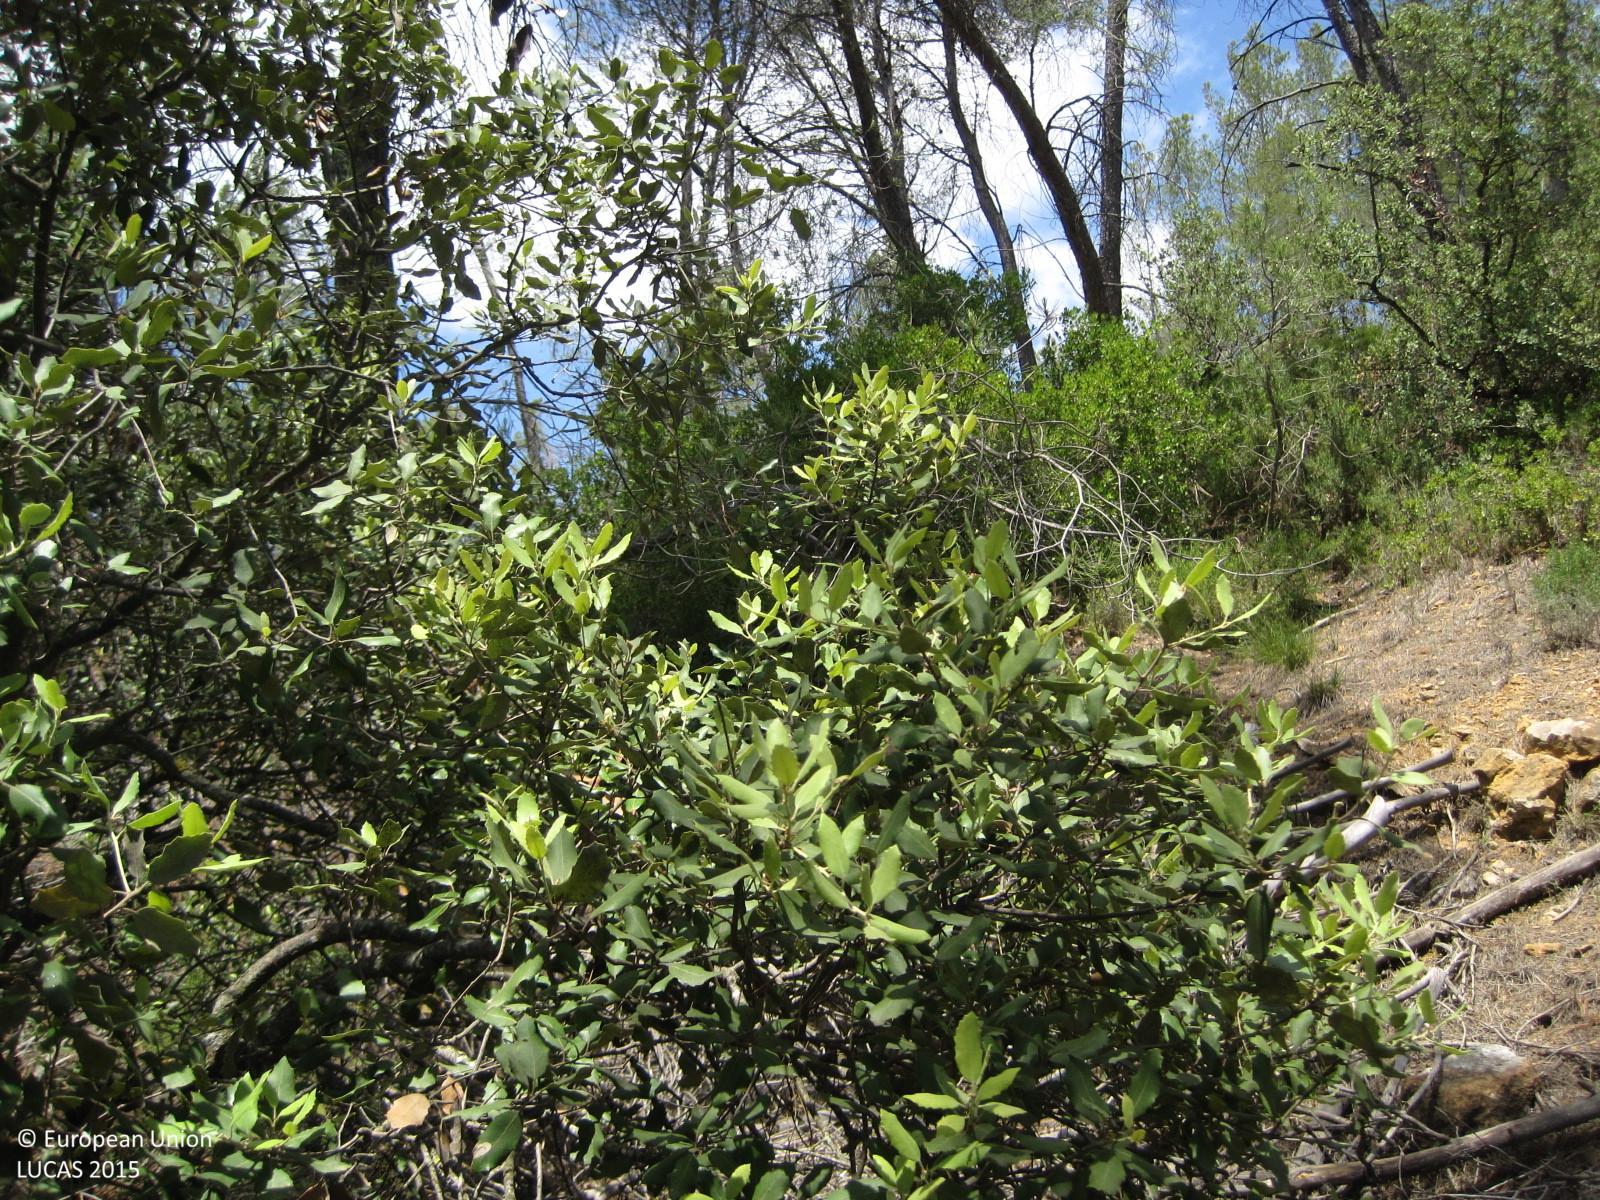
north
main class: Woodland
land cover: Pine dominated coniferous woodland
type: coniferous forest of the mediterranean region
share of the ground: 50 - 75 %
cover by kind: coniferous forest trees 60 %, shrubs 20 %, broadleaved forest trees 15 %, herbaceous plants 5 %
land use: Forestry
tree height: > 5 m
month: May
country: ES
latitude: 39.5988
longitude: -1.1006
